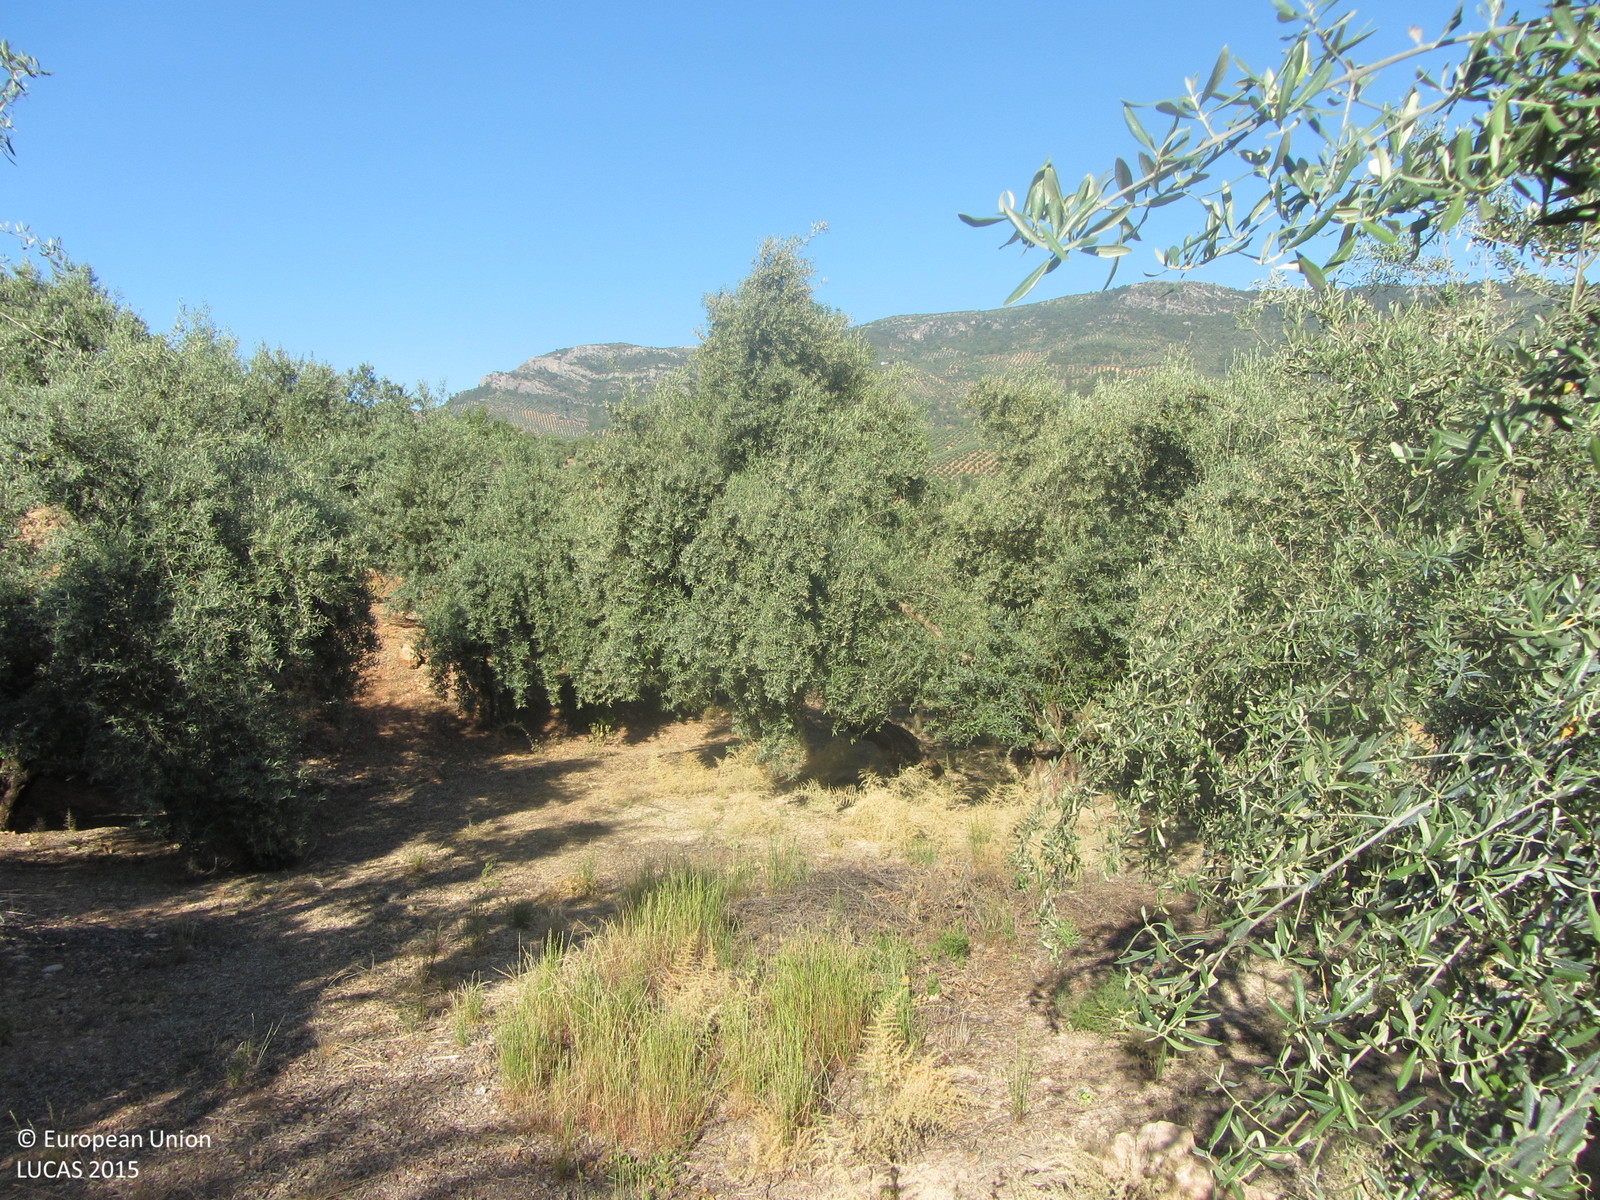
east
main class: Cropland
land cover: Olive groves
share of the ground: 25 - 50 %
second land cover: Other bare soil
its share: > 75 %
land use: Agriculture (excluding fallow land and kitchen gardens)
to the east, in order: Olive groves; Other bare soil; Single bushes/trees; Olive groves; Single bushes/trees; Olive groves; Rock outcrops; Olive groves; Other structural elements; Olive groves; Rock outcrops; Olive groves; Shruby margins; Other structural elements; Single bushes/trees; Olive groves; Tracks; Olive groves
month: May
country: ES
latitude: 38.1177
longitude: -2.9897
